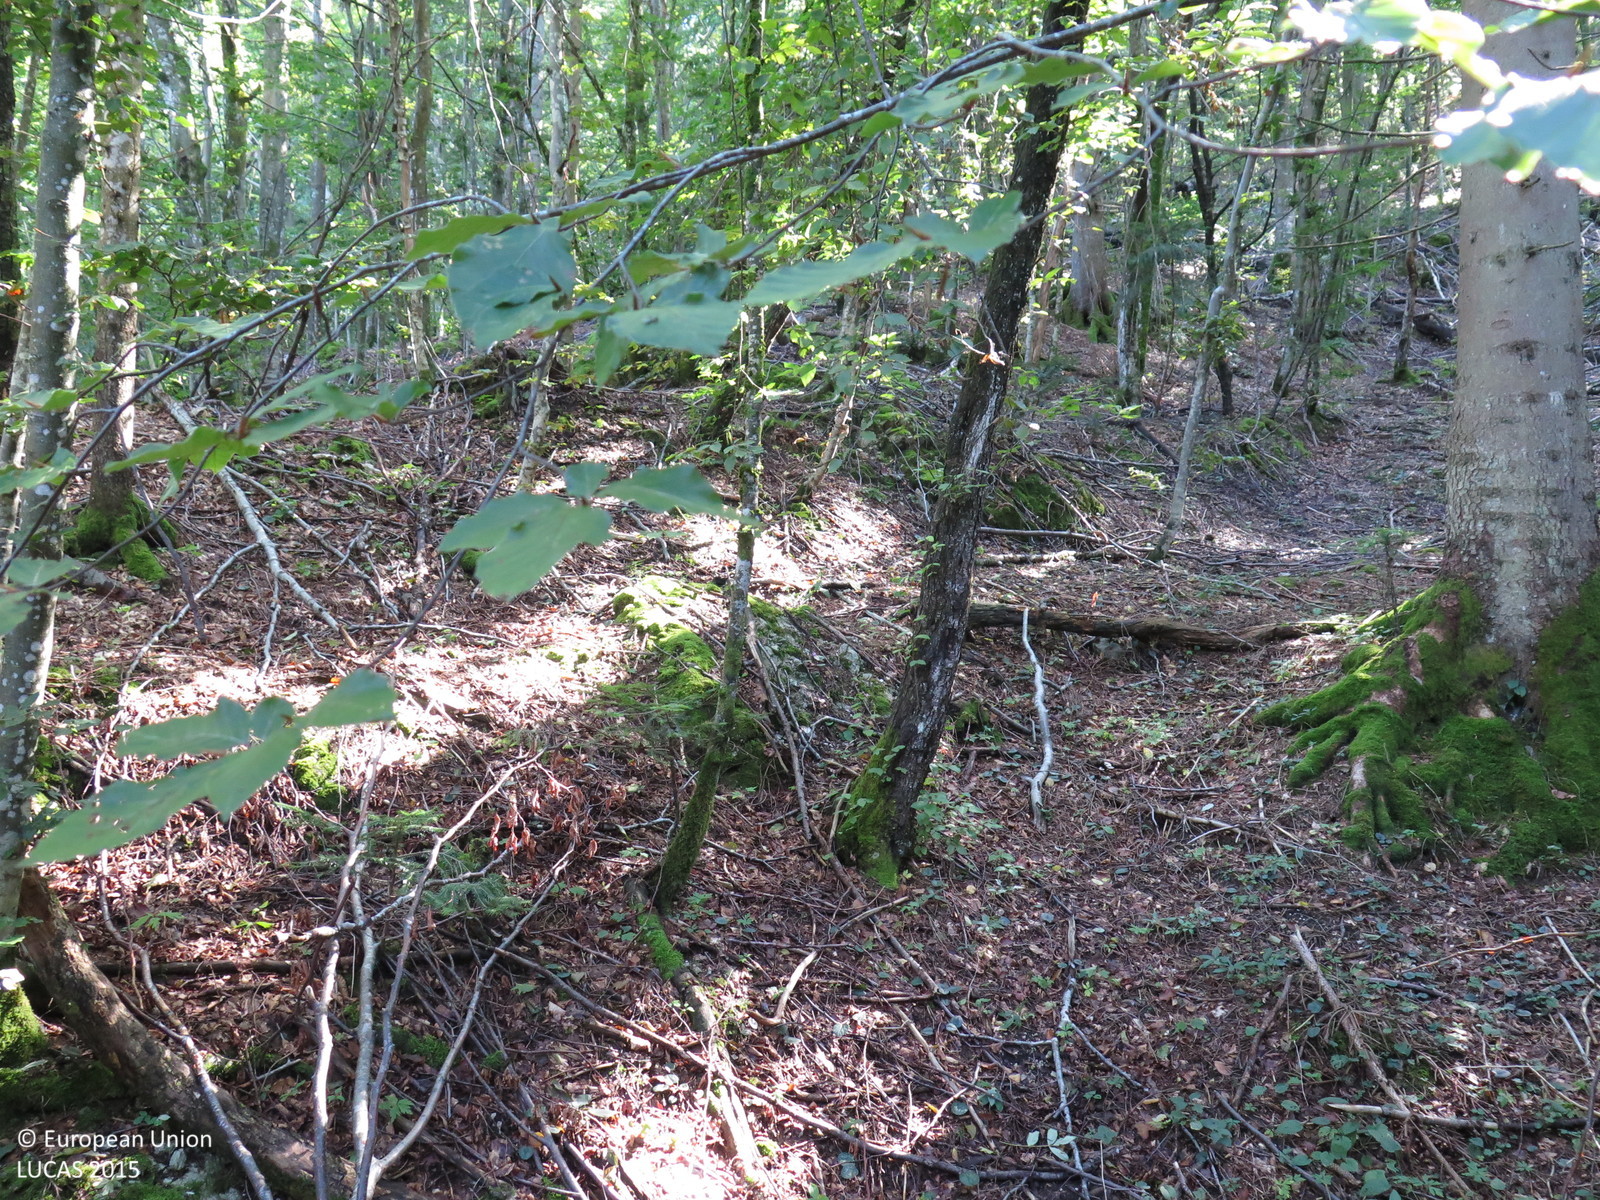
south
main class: Woodland
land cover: Other mixed woodland
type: beech forest
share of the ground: > 75 %
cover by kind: broadleaved forest trees 75 %, coniferous forest trees 25 %
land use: Forestry
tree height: > 5 m
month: September
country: HR
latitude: 45.4533
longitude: 14.7138
